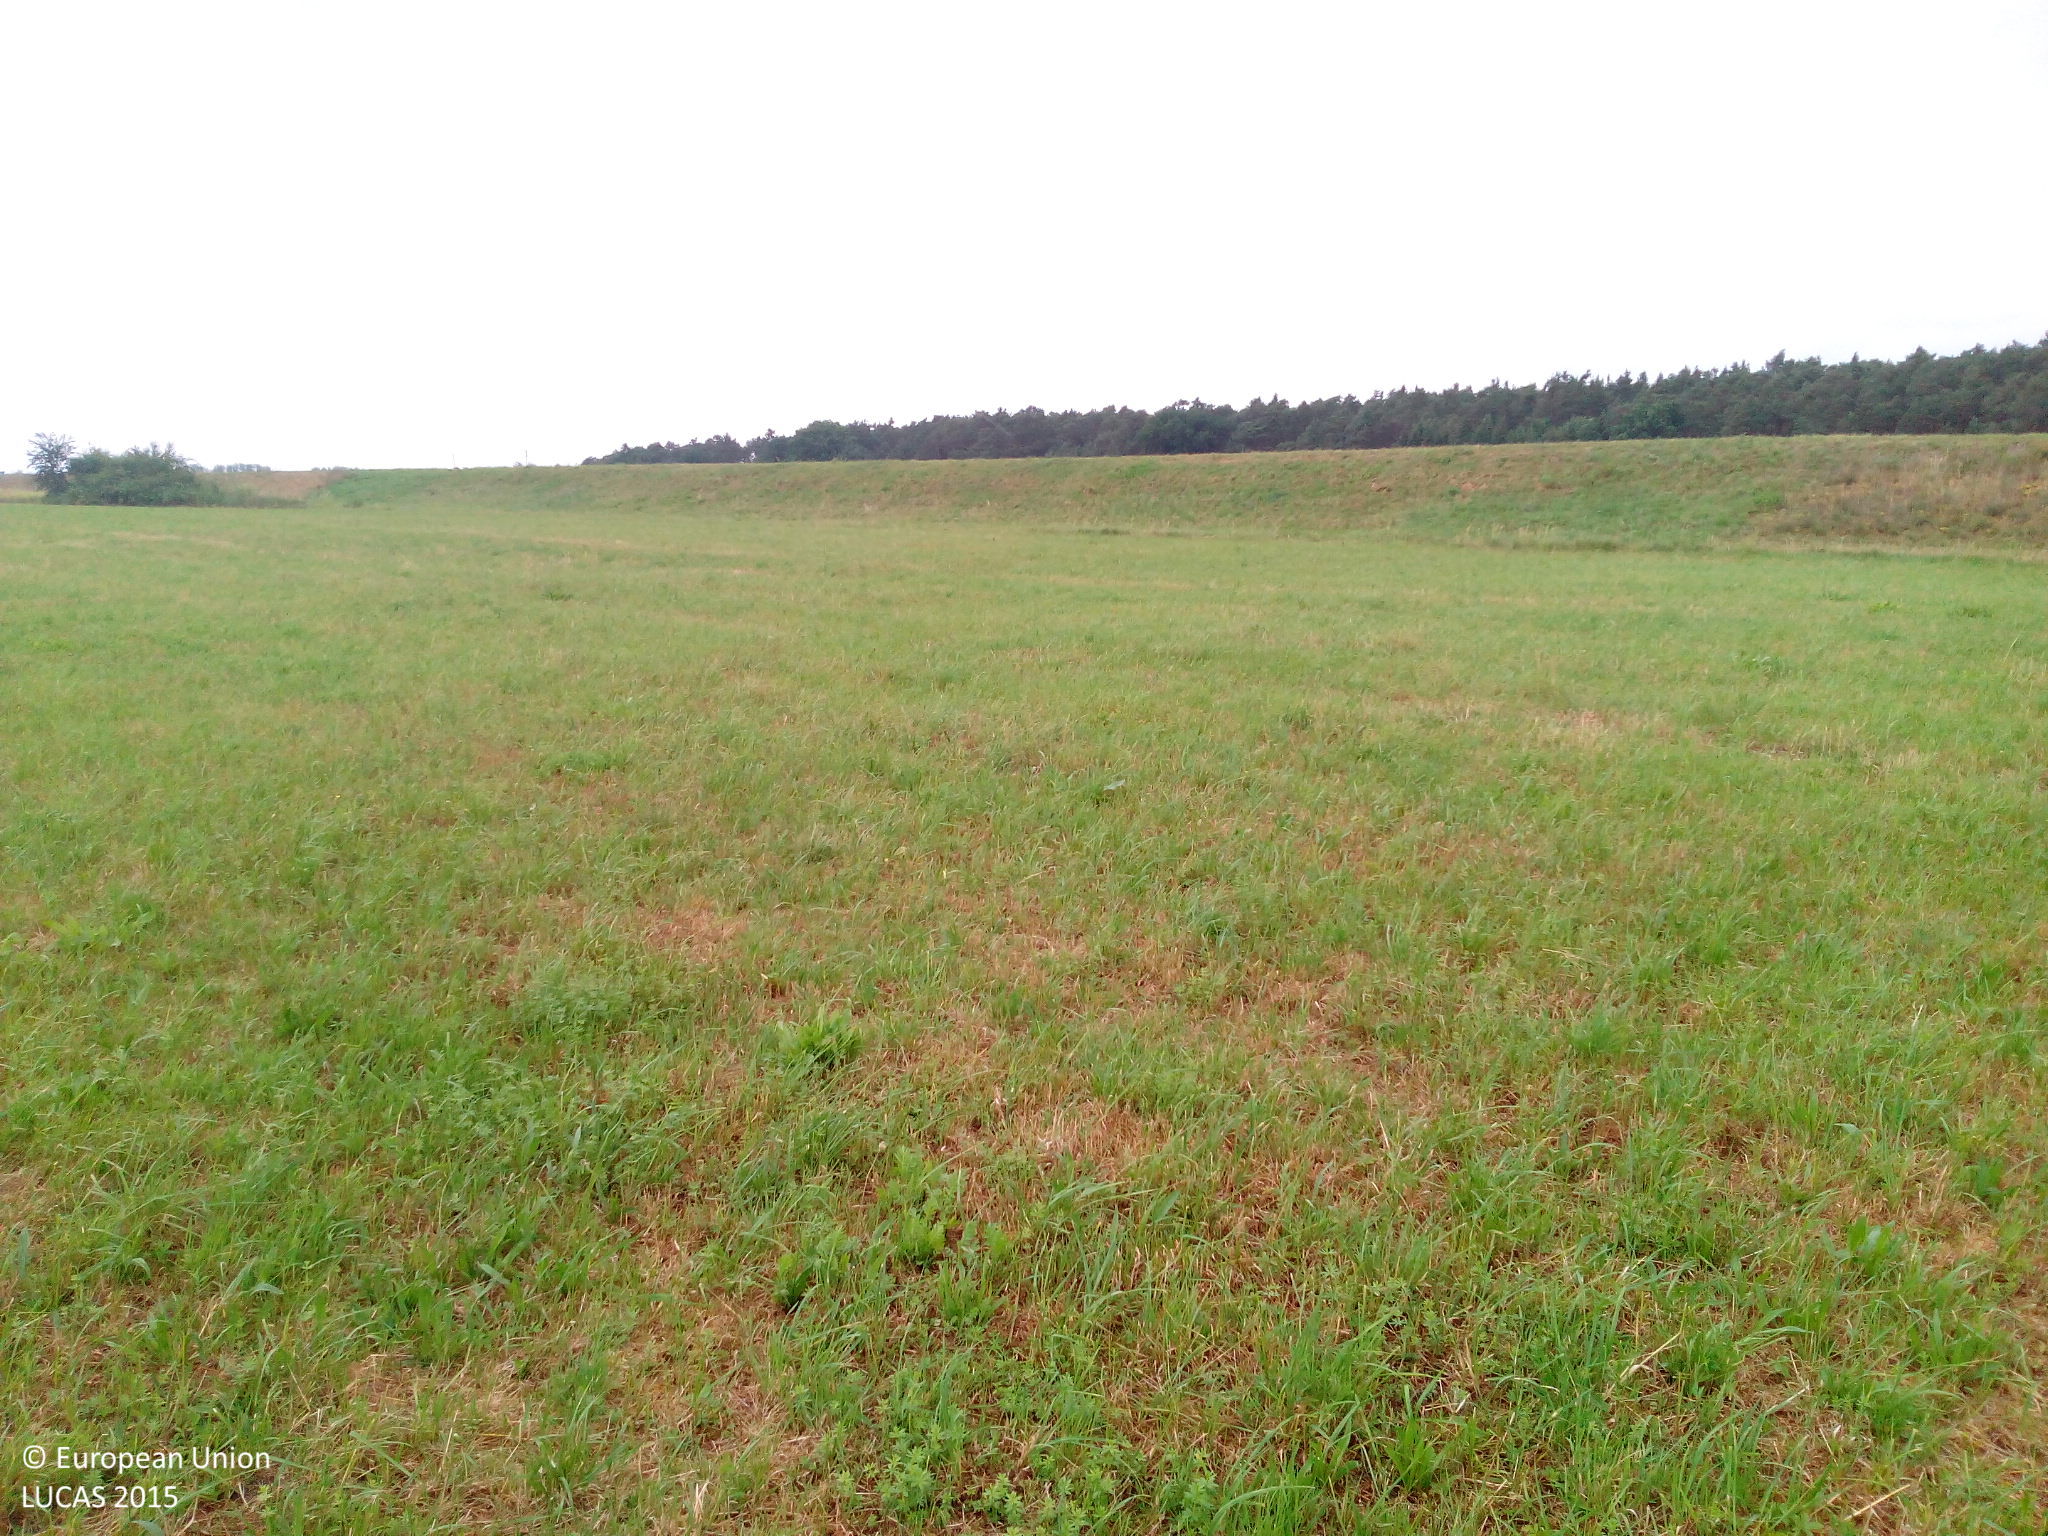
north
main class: Grassland
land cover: Grassland without tree/shrub cover
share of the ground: > 75 %
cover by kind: herbaceous plants 100 %
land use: Agriculture (excluding fallow land and kitchen gardens)
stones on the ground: < 10 %
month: June
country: DE
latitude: 49.8567
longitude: 10.9316
